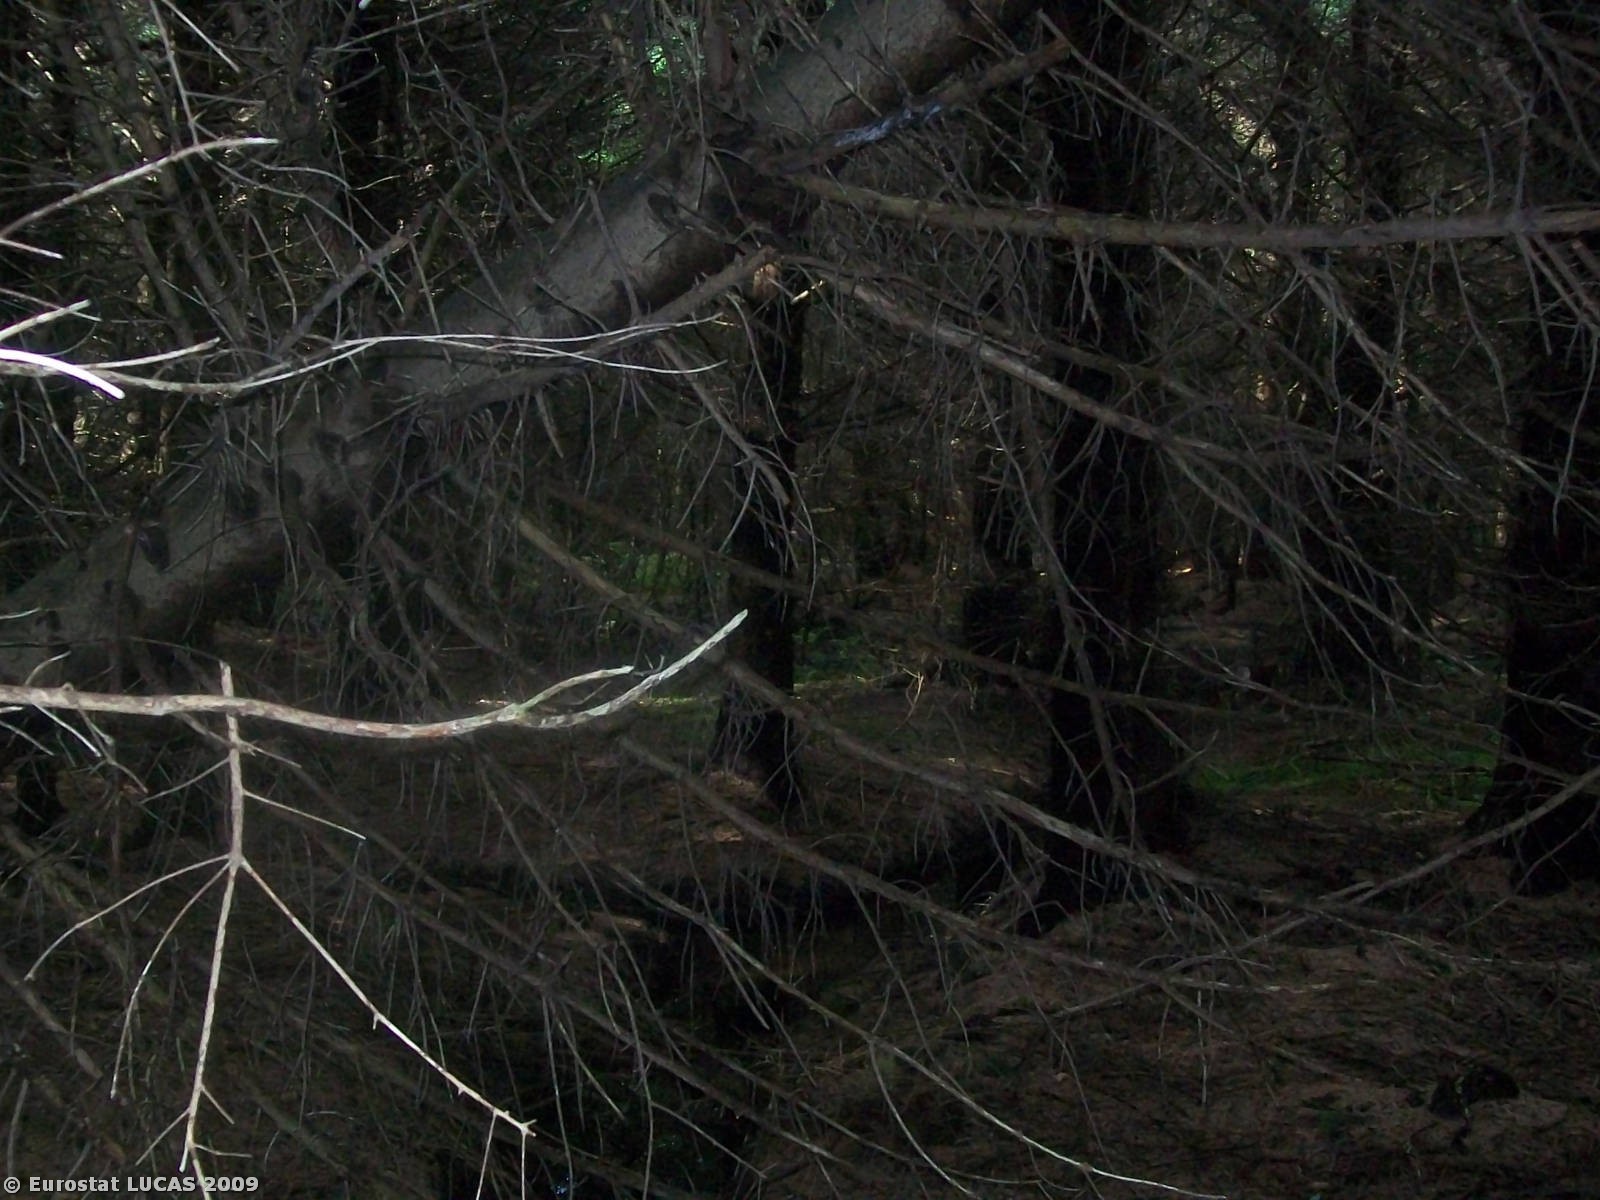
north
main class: Woodland
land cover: Coniferous woodland
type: plantations and self-sown exotic forest
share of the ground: > 75 %
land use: Forestry
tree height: > 5 m
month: July
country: IE
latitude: 54.3753
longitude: -8.5274
